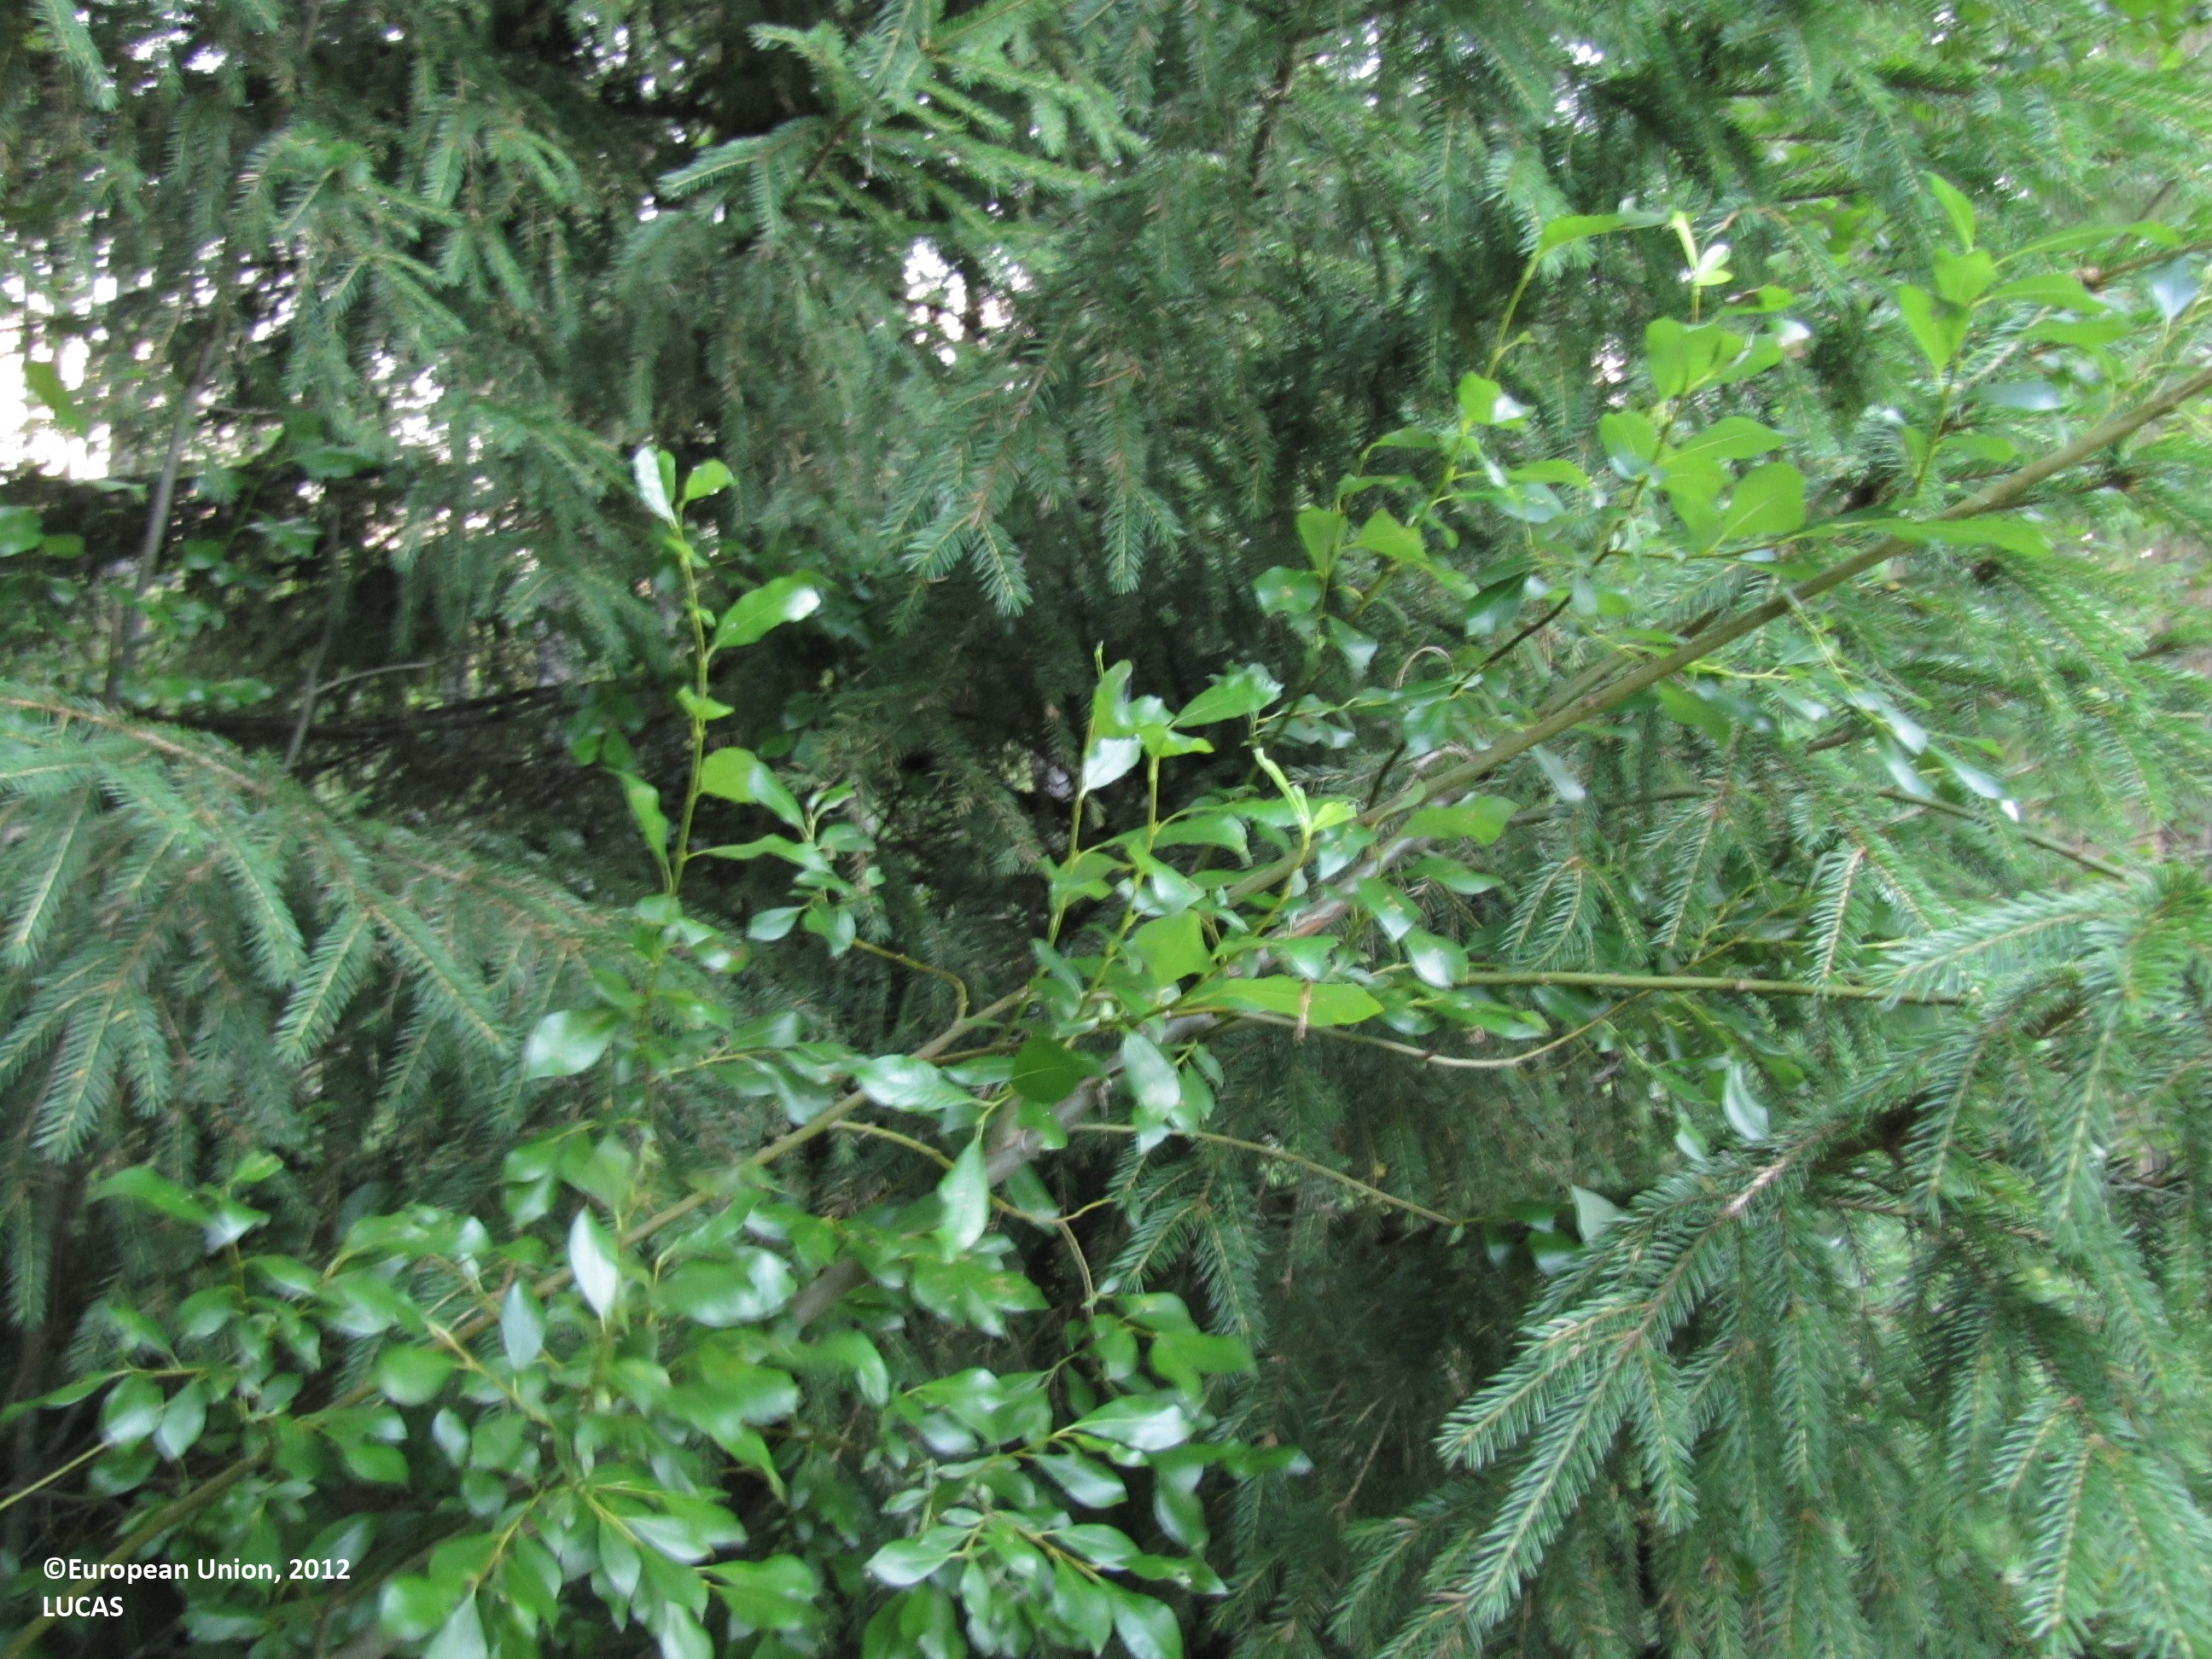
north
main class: Woodland
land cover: Other mixed woodland
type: boreal forest
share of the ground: 25 - 50 %
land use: Forestry
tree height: > 5 m
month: July
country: FI
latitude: 61.9661
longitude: 23.8717
